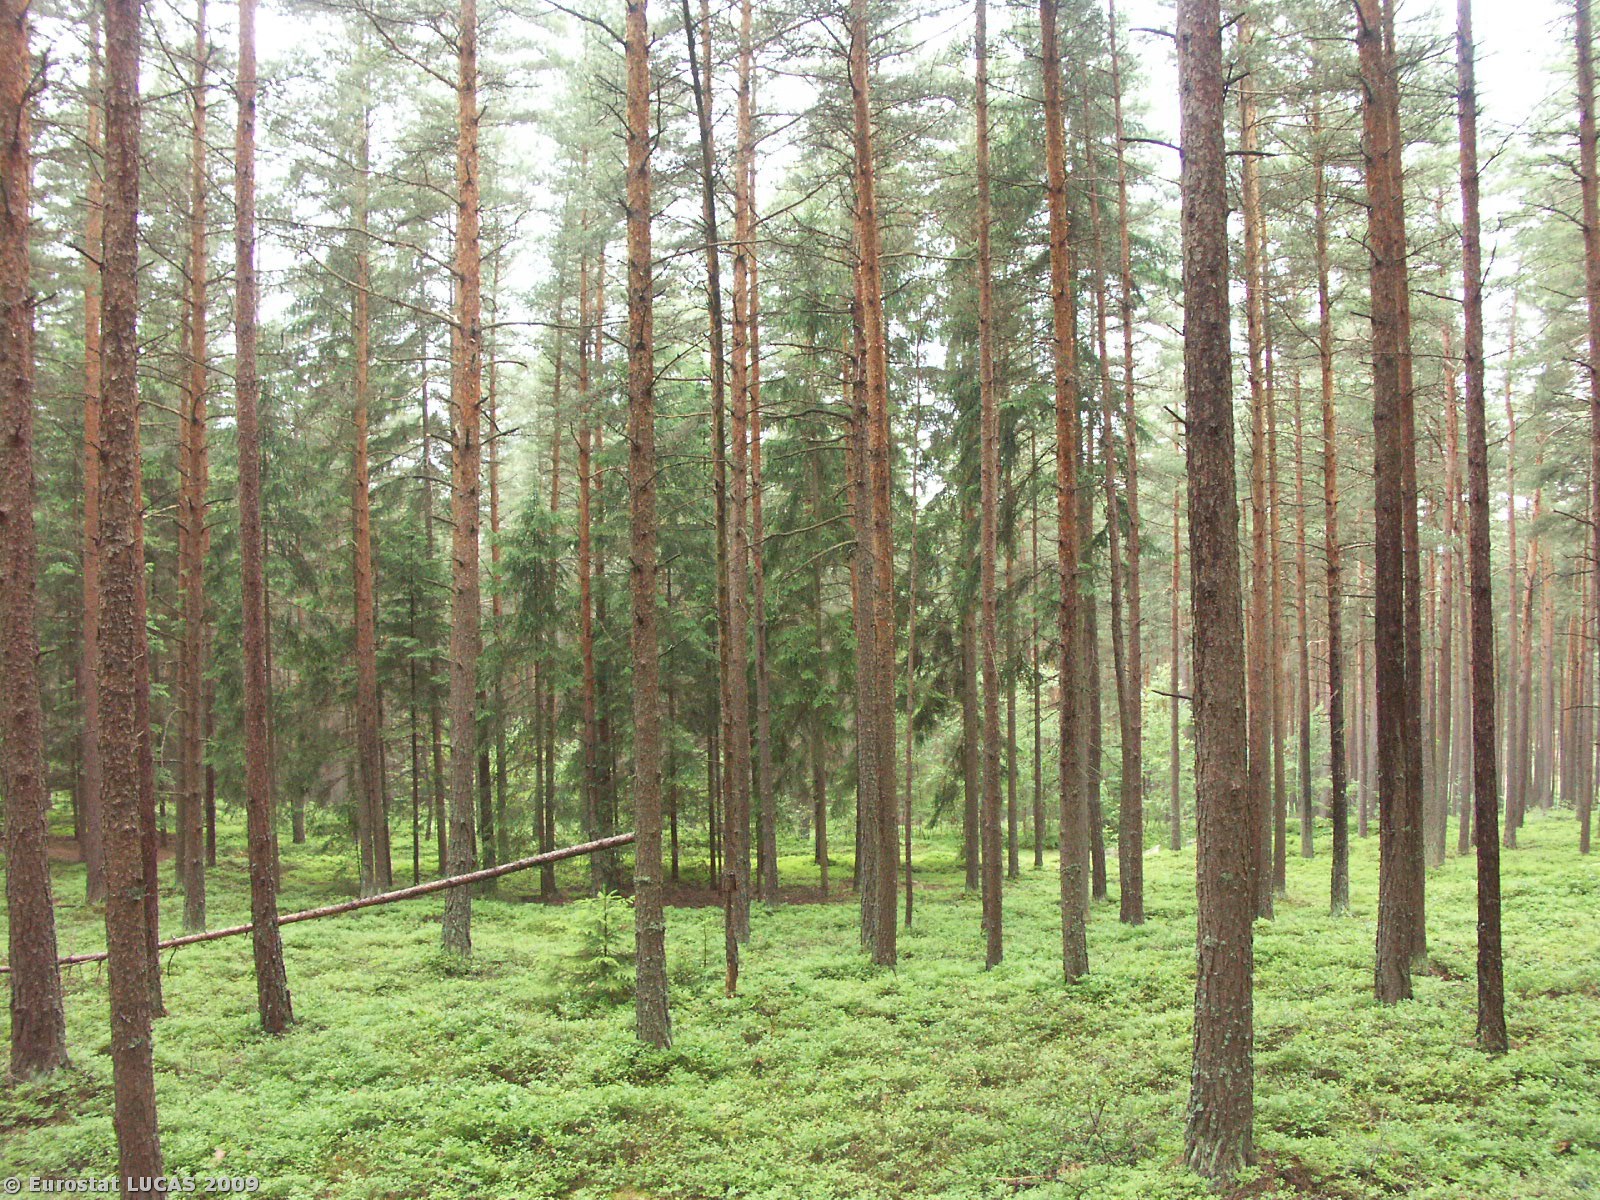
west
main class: Woodland
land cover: Coniferous woodland
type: hemiboreal forest and nemoral coniferous forest and mixed broadleaved-coniferous forest
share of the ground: > 75 %
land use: Forestry
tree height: > 5 m
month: June
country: CZ
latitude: 48.6811
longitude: 14.2789
